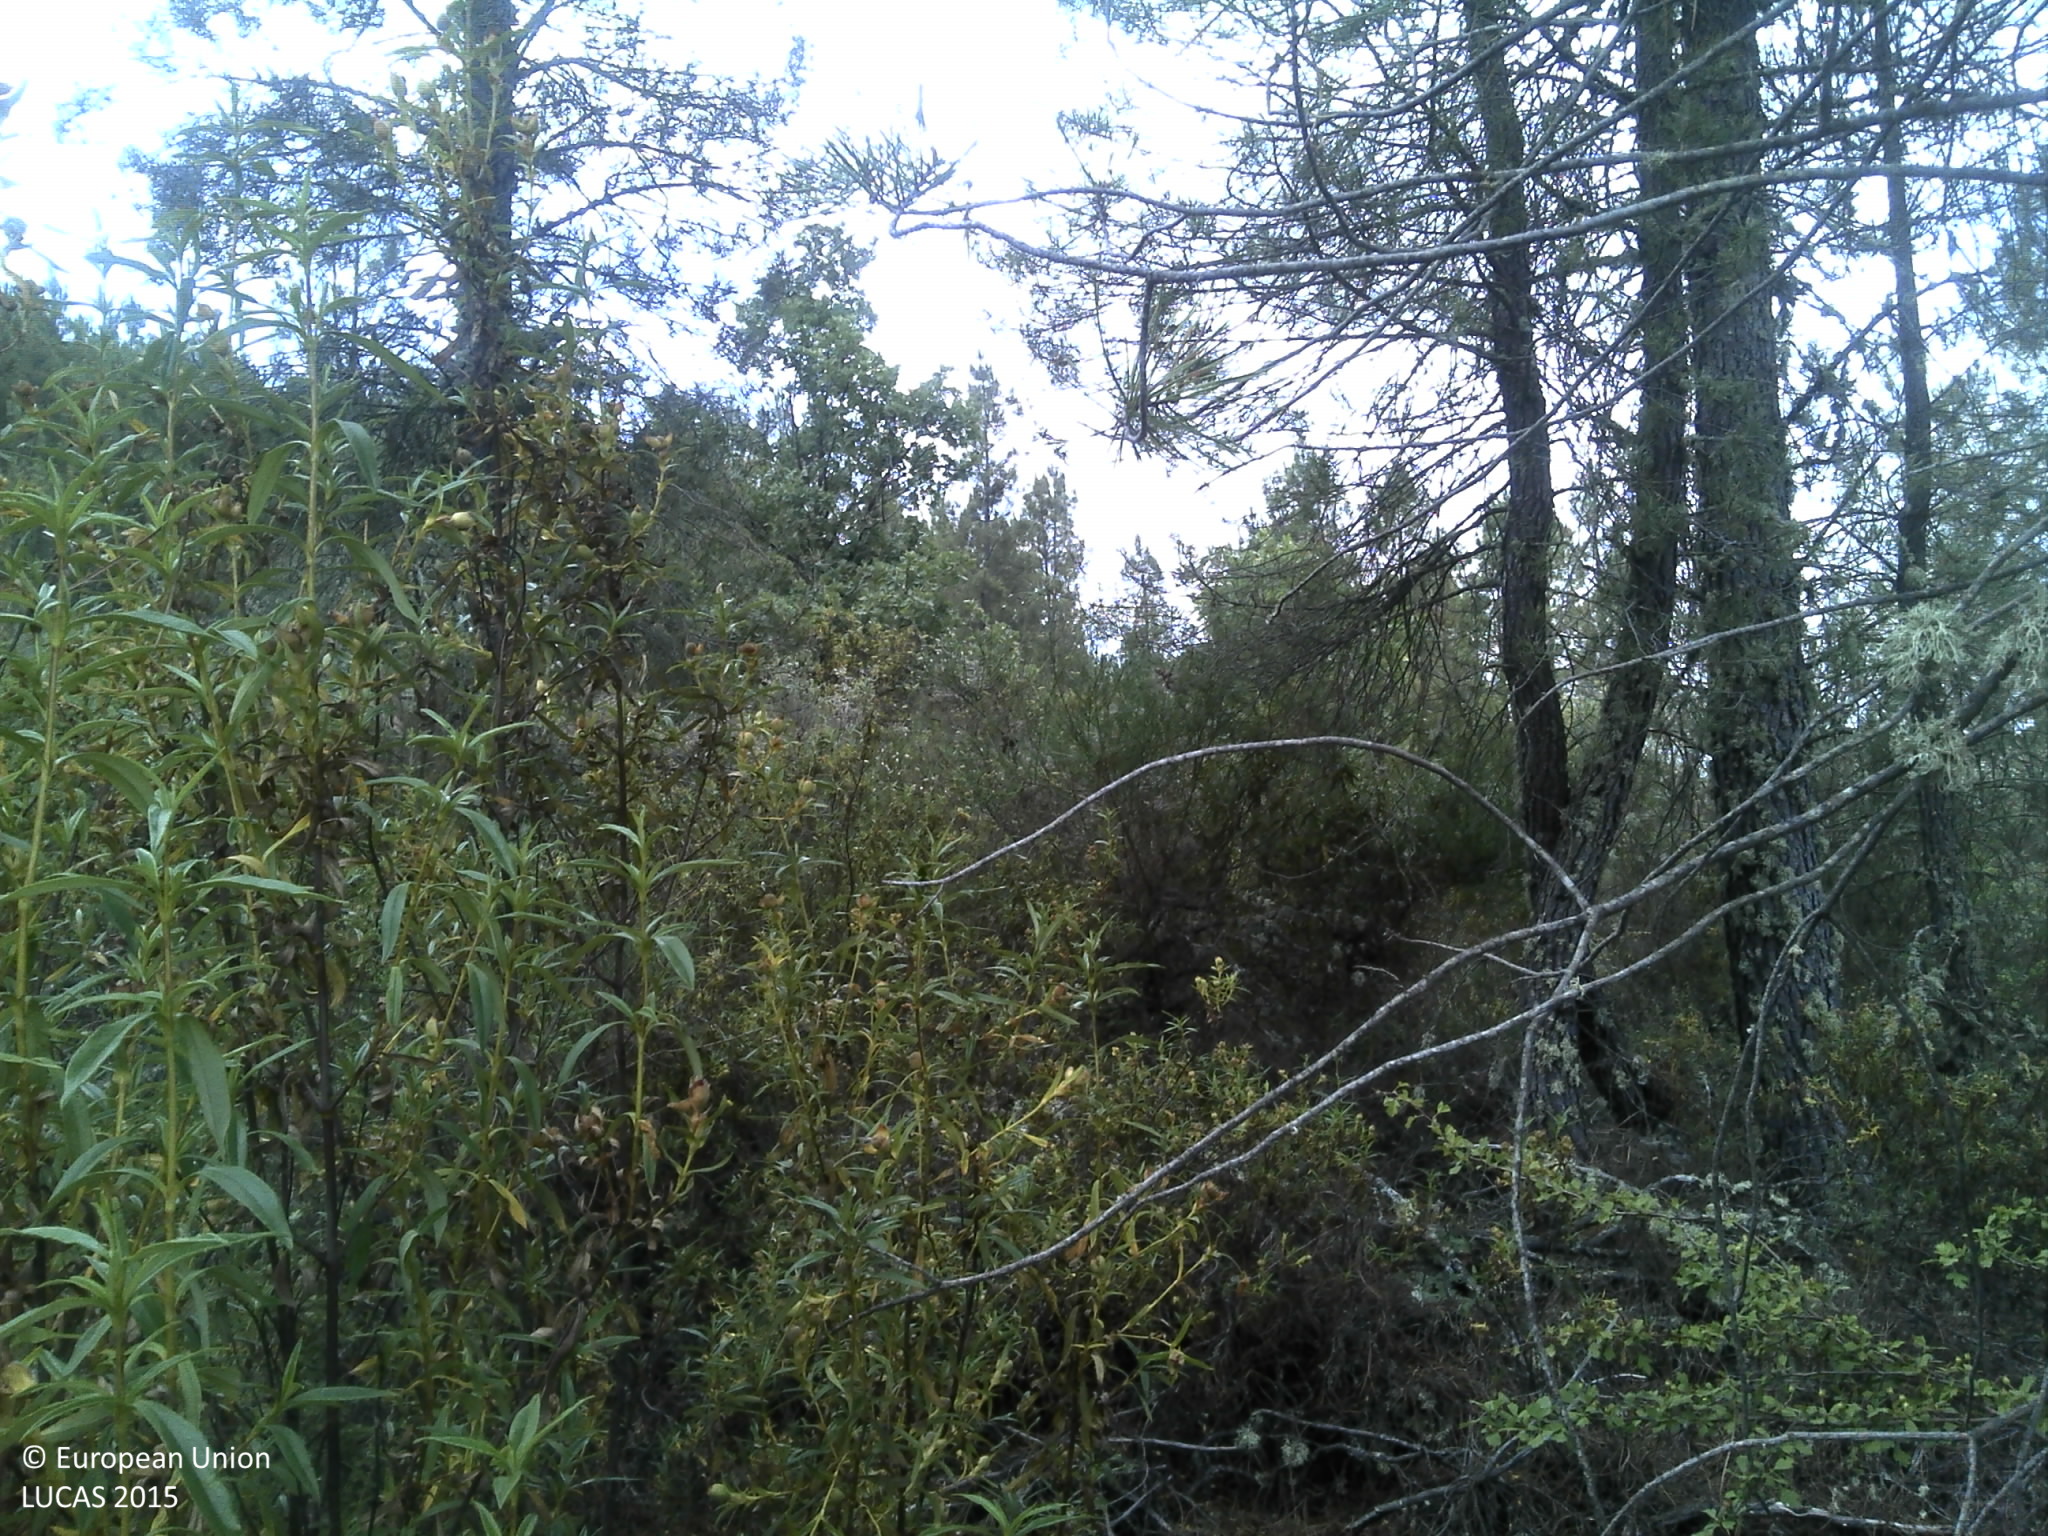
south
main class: Woodland
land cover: Pine dominated coniferous woodland
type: coniferous forest of the mediterranean region
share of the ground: 50 - 75 %
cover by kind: coniferous forest trees 60 %, shrubs 30 %, unconsolidated bare surface 5 %
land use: Forestry
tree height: > 5 m
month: June
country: PT
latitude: 40.2133
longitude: -7.2911
